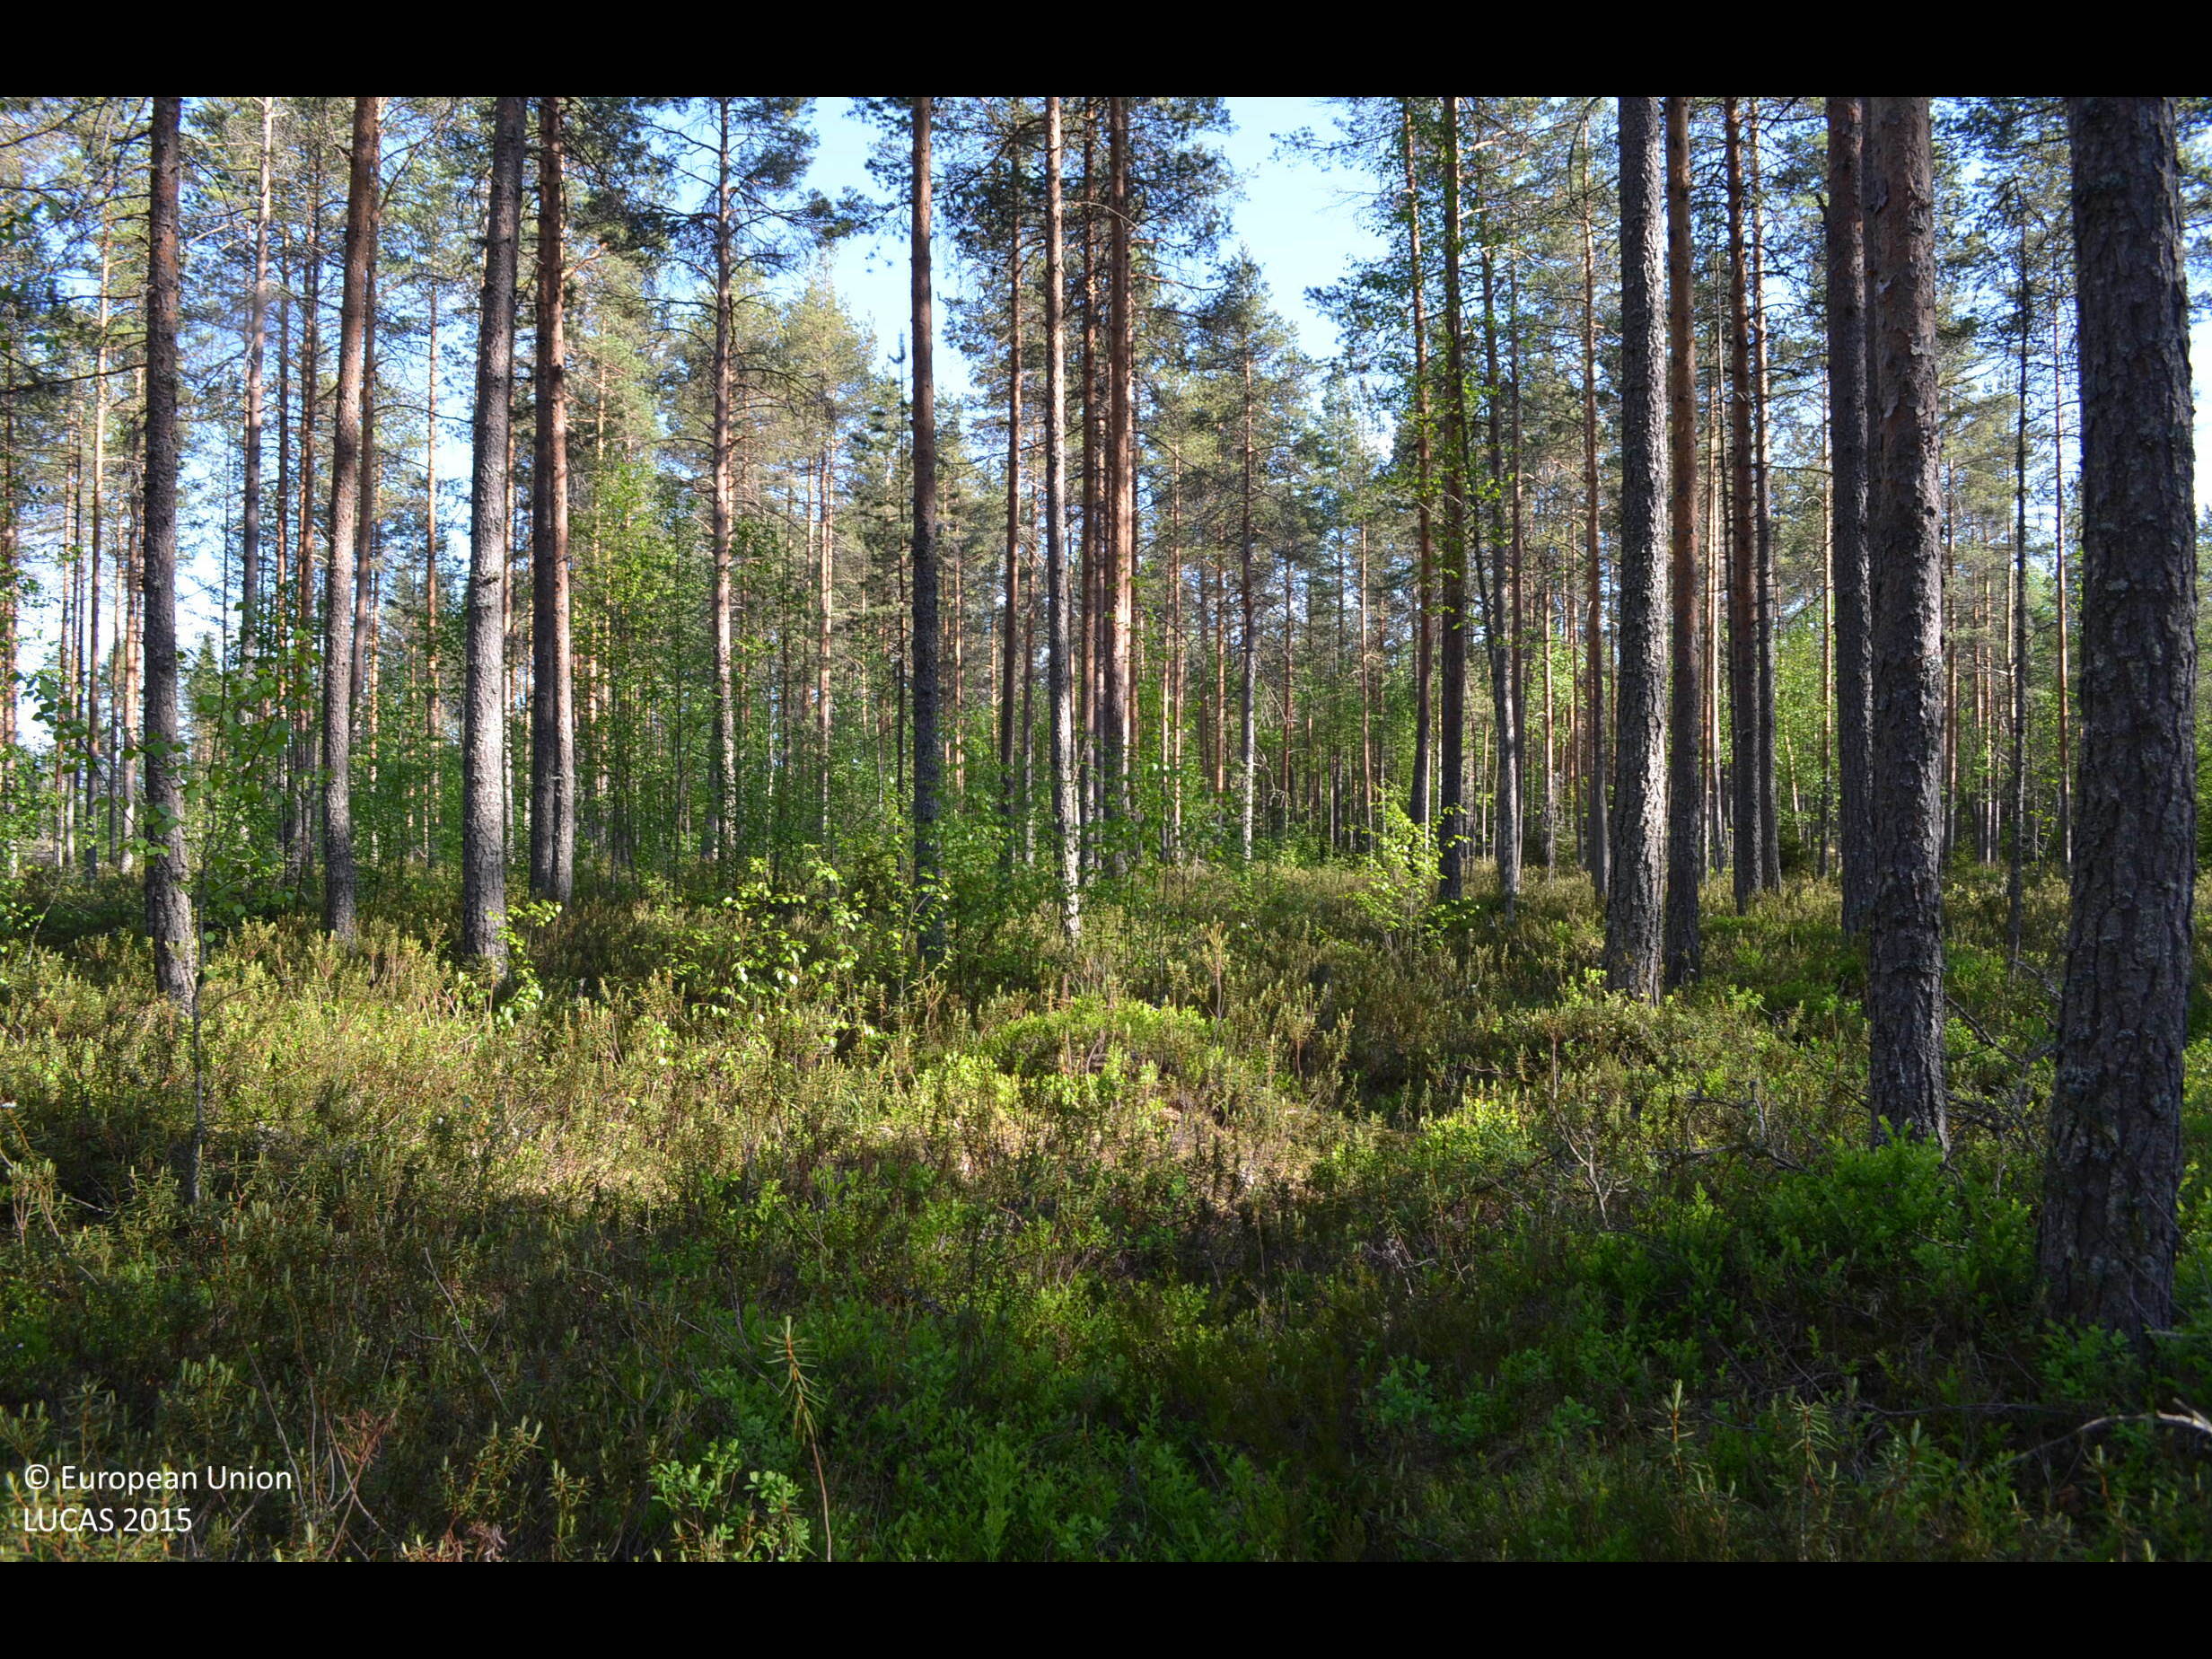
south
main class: Woodland
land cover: Pine dominated coniferous woodland
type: boreal forest
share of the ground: 50 - 75 %
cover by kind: coniferous forest trees 70 %, shrubs 30 %
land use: Forestry
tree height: > 5 m
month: June
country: FI
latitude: 61.8910
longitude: 23.2958
